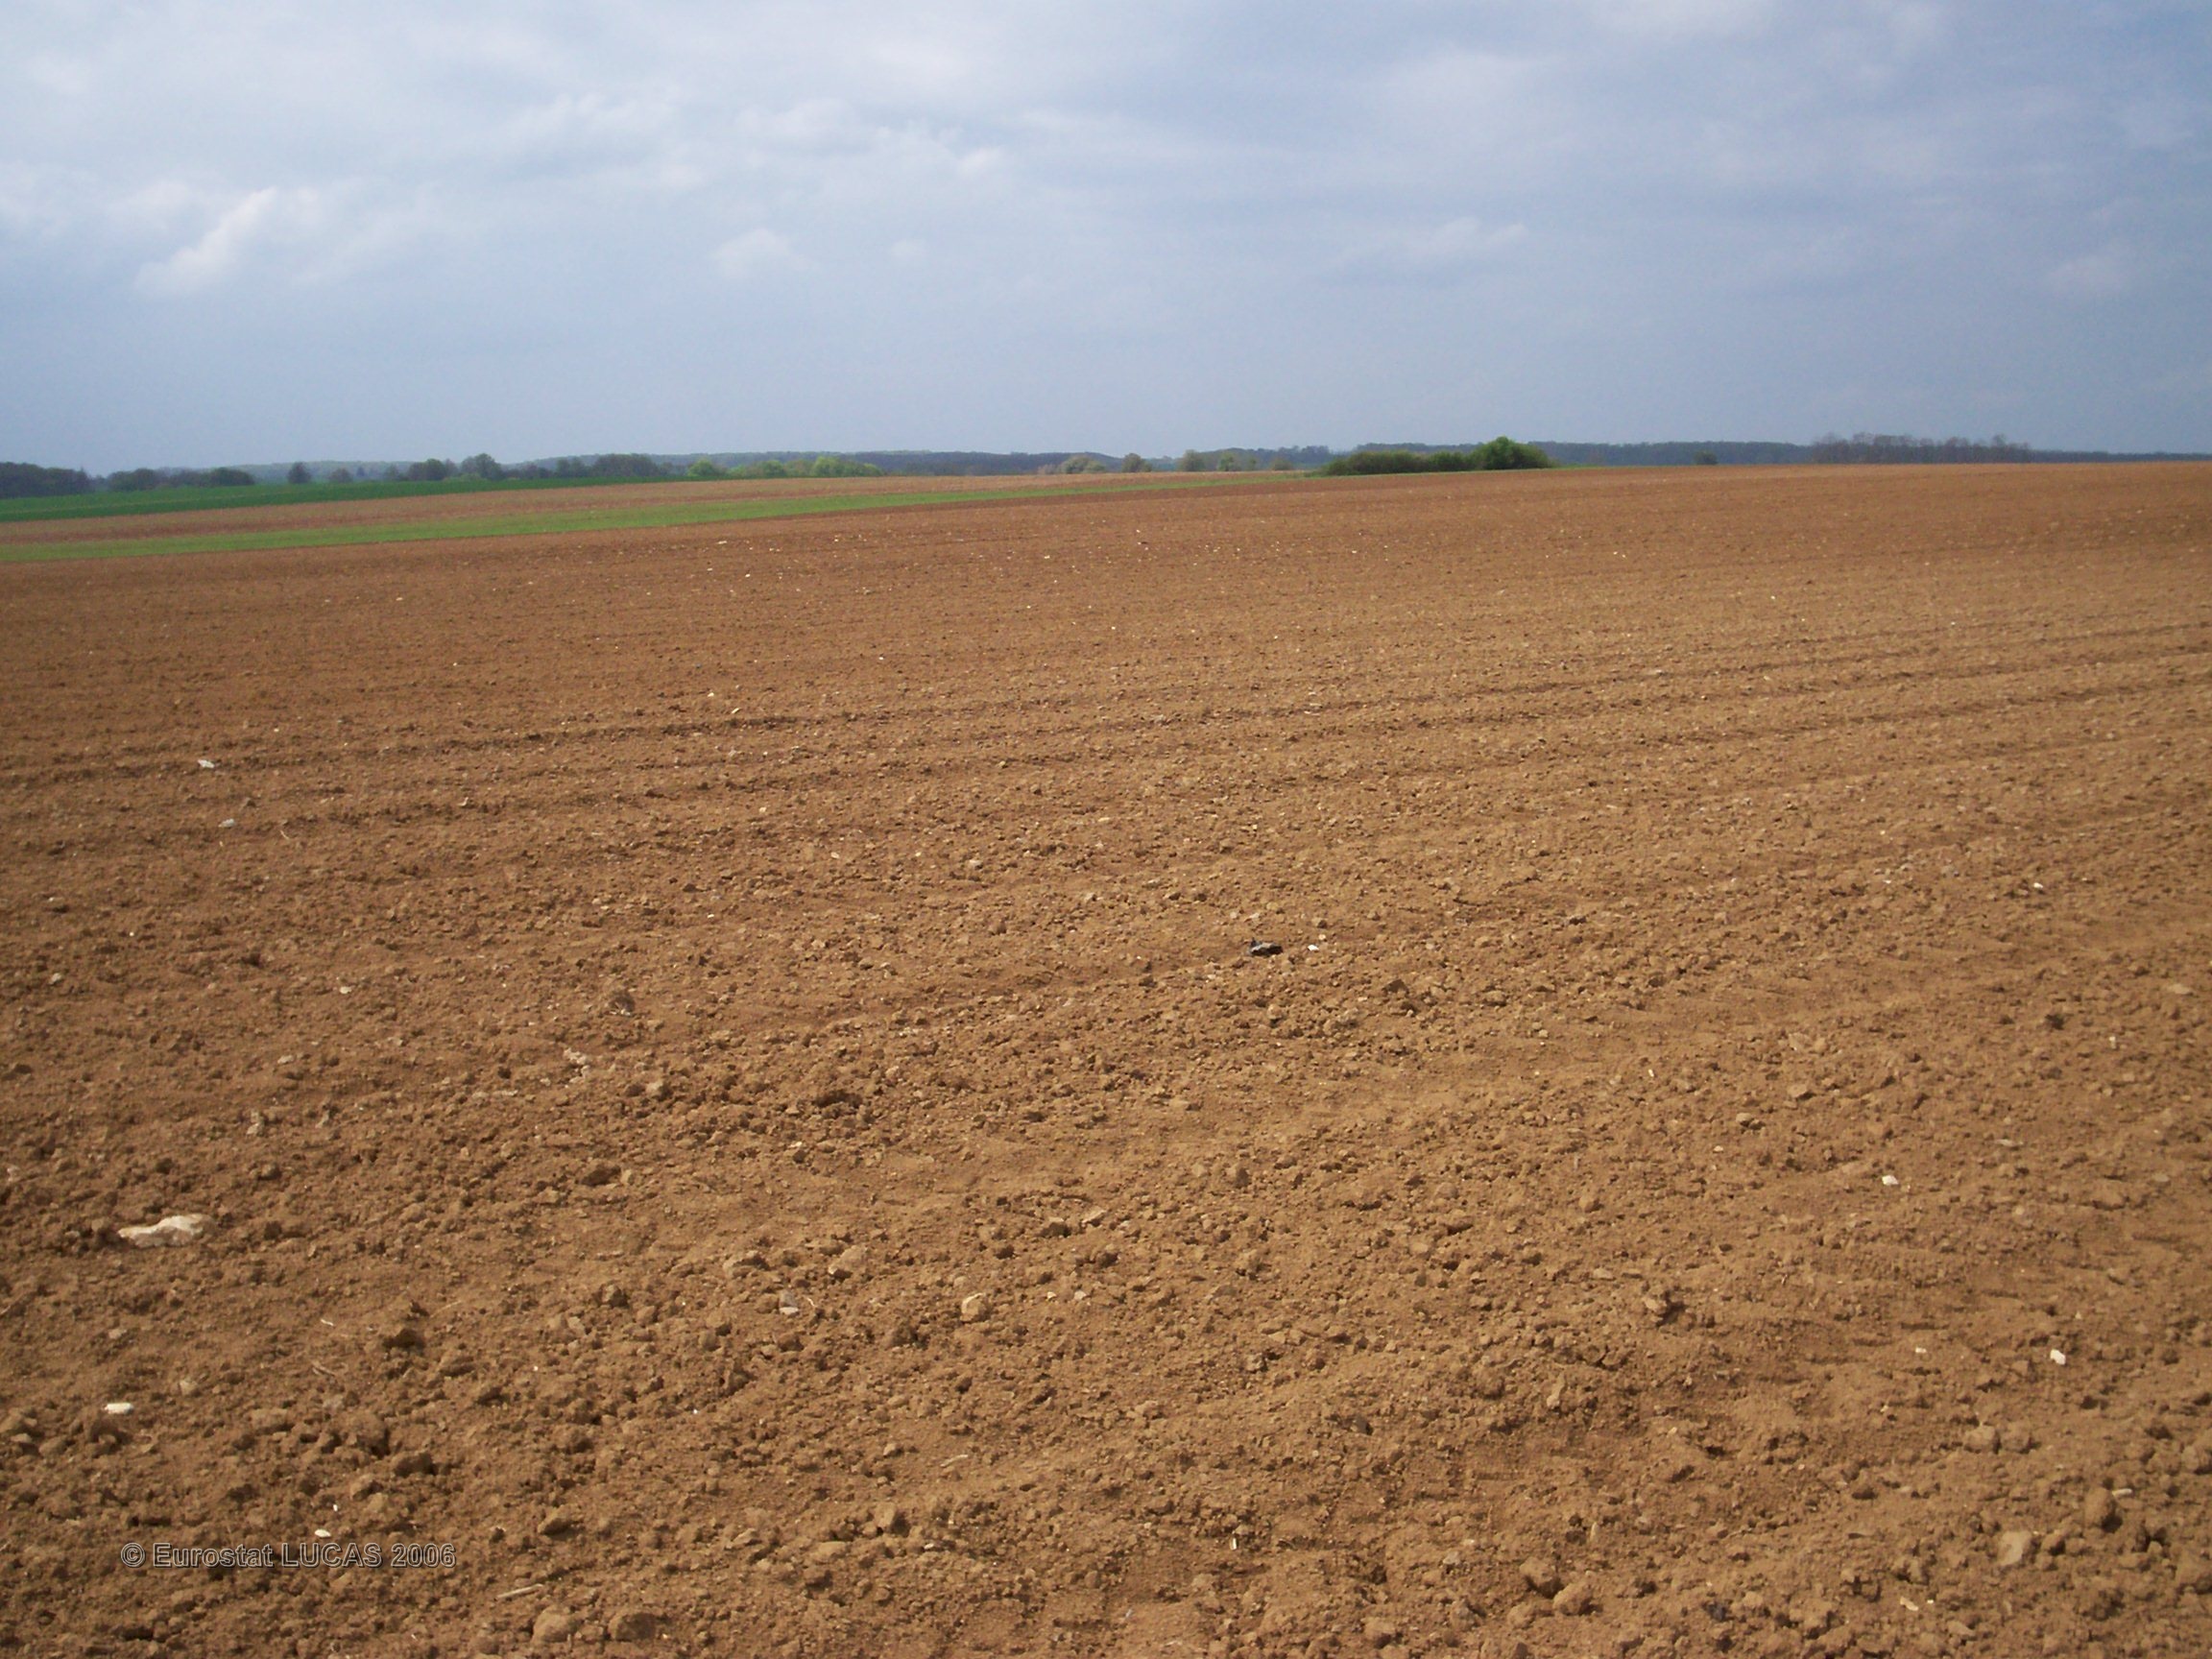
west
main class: Cropland
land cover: Maize
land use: Agriculture (excluding fallow land and kitchen gardens)
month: June
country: FR
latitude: 47.5744
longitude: 5.9997
